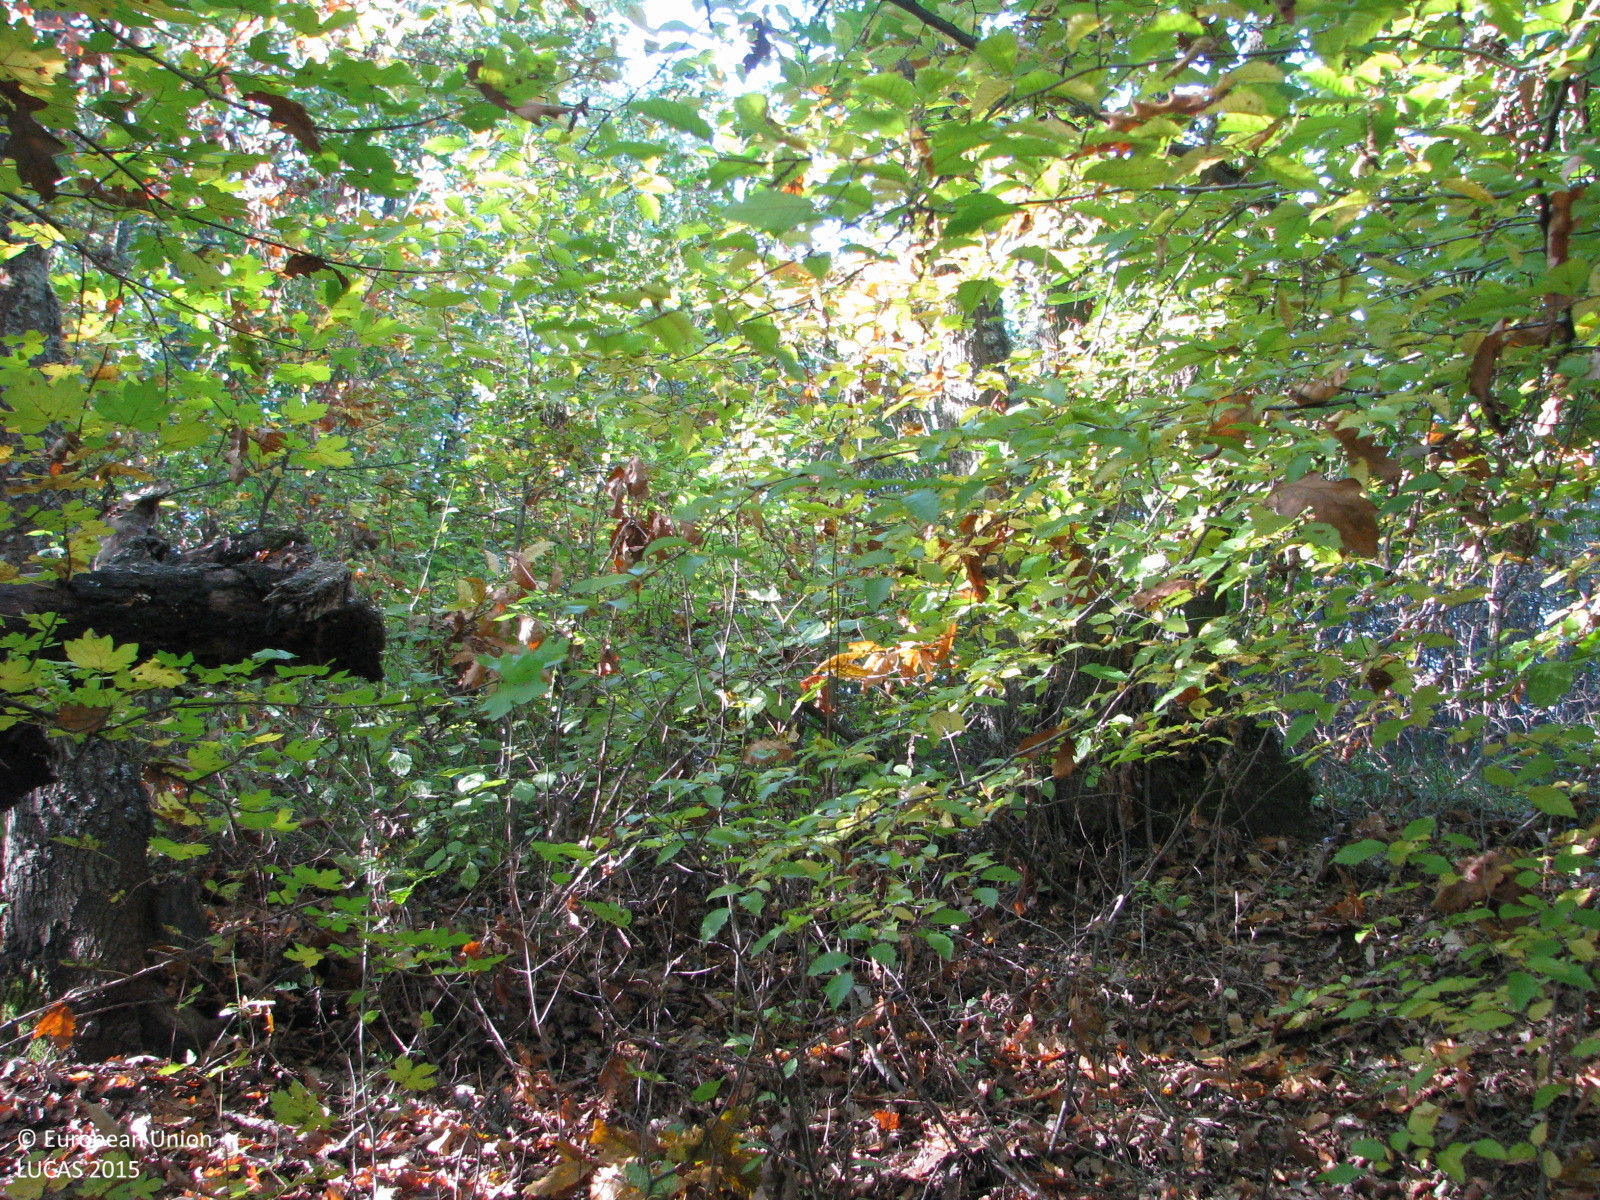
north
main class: Woodland
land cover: Broadleaved woodland
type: thermophilous deciduous forest
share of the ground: 50 - 75 %
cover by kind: broadleaved forest trees 70 %, unconsolidated bare surface 20 %, shrubs 10 %
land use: Forestry
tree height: > 5 m
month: October
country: BG
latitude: 42.3469
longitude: 26.8879
